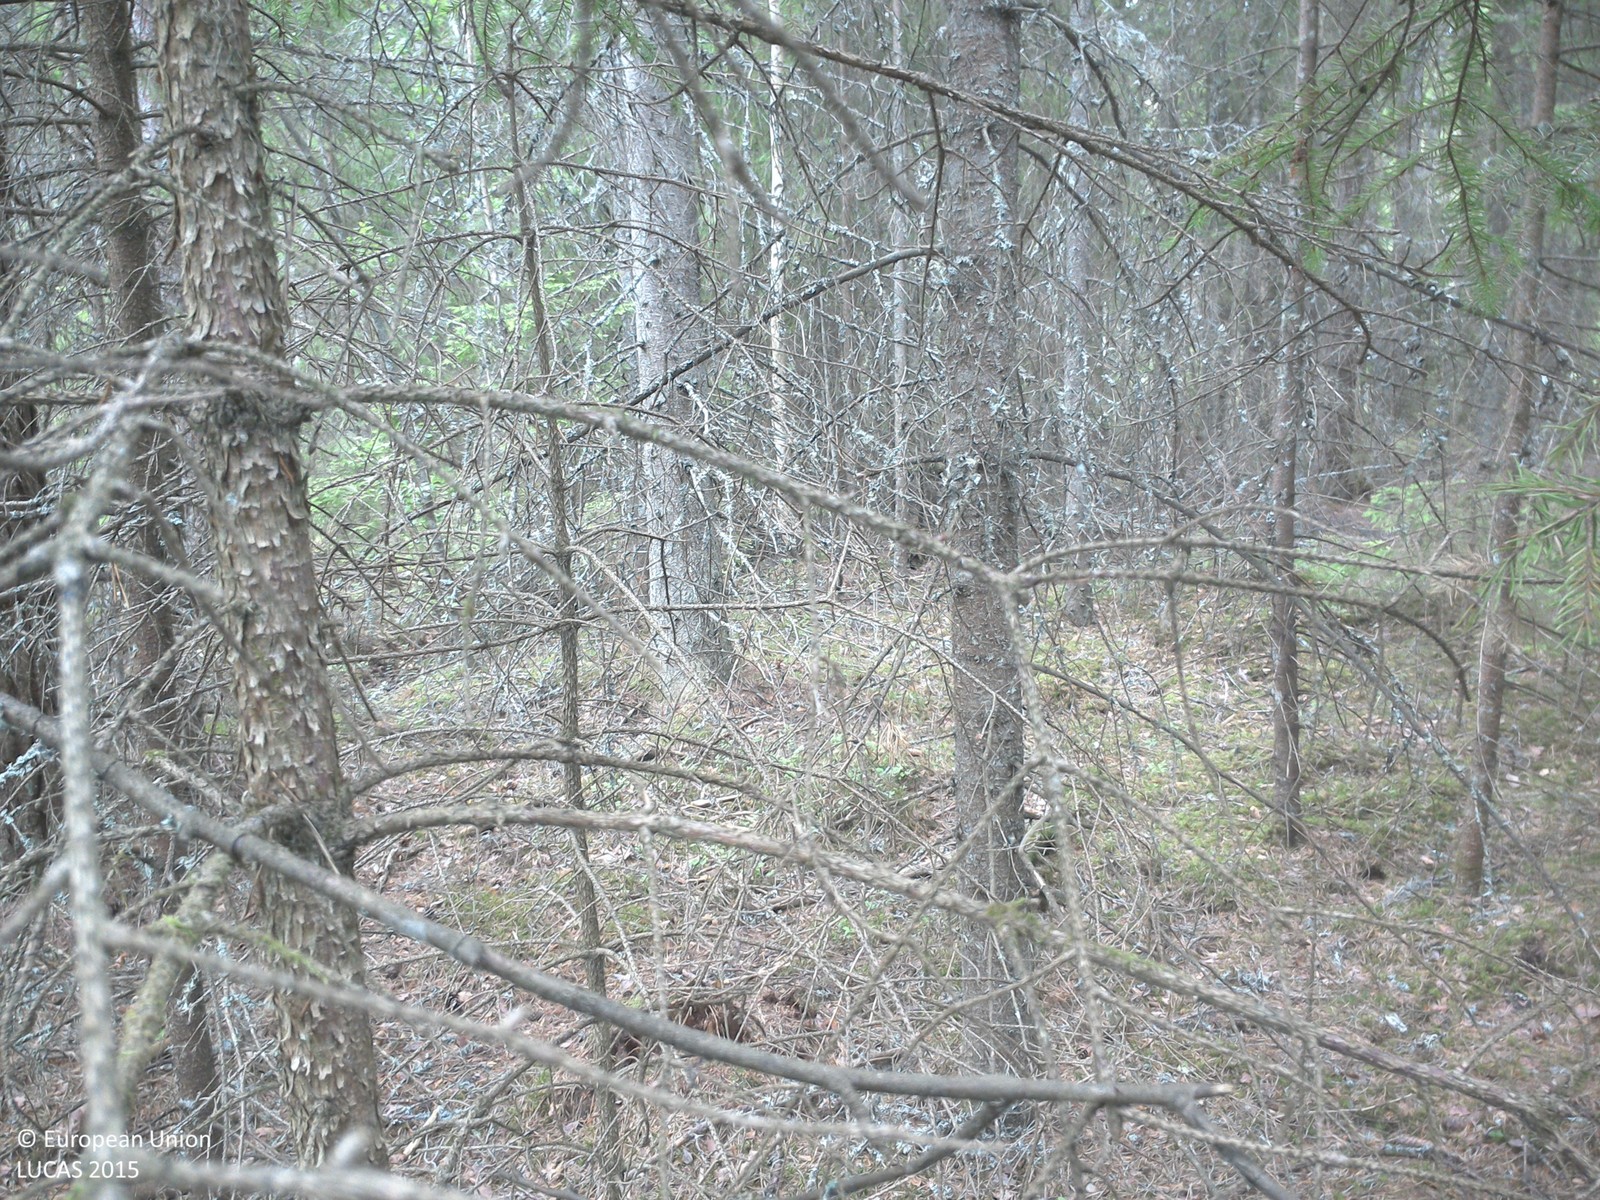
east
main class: Woodland
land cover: Spruce dominated coniferous woodland
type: boreal forest
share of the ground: > 75 %
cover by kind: coniferous forest trees 75 %, lichens and mosses 25 %
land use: Forestry
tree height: > 5 m
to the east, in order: Spruce dominated coniferous woodland; Shrubland without tree cover; Spruce dominated coniferous woodland; Spontaneously vegetated surfaces; Paved roads, cycling and walking lanes; Spontaneously vegetated surfaces; Pine dominated coniferous woodland
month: June
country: SE
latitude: 58.2471
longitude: 15.6001
